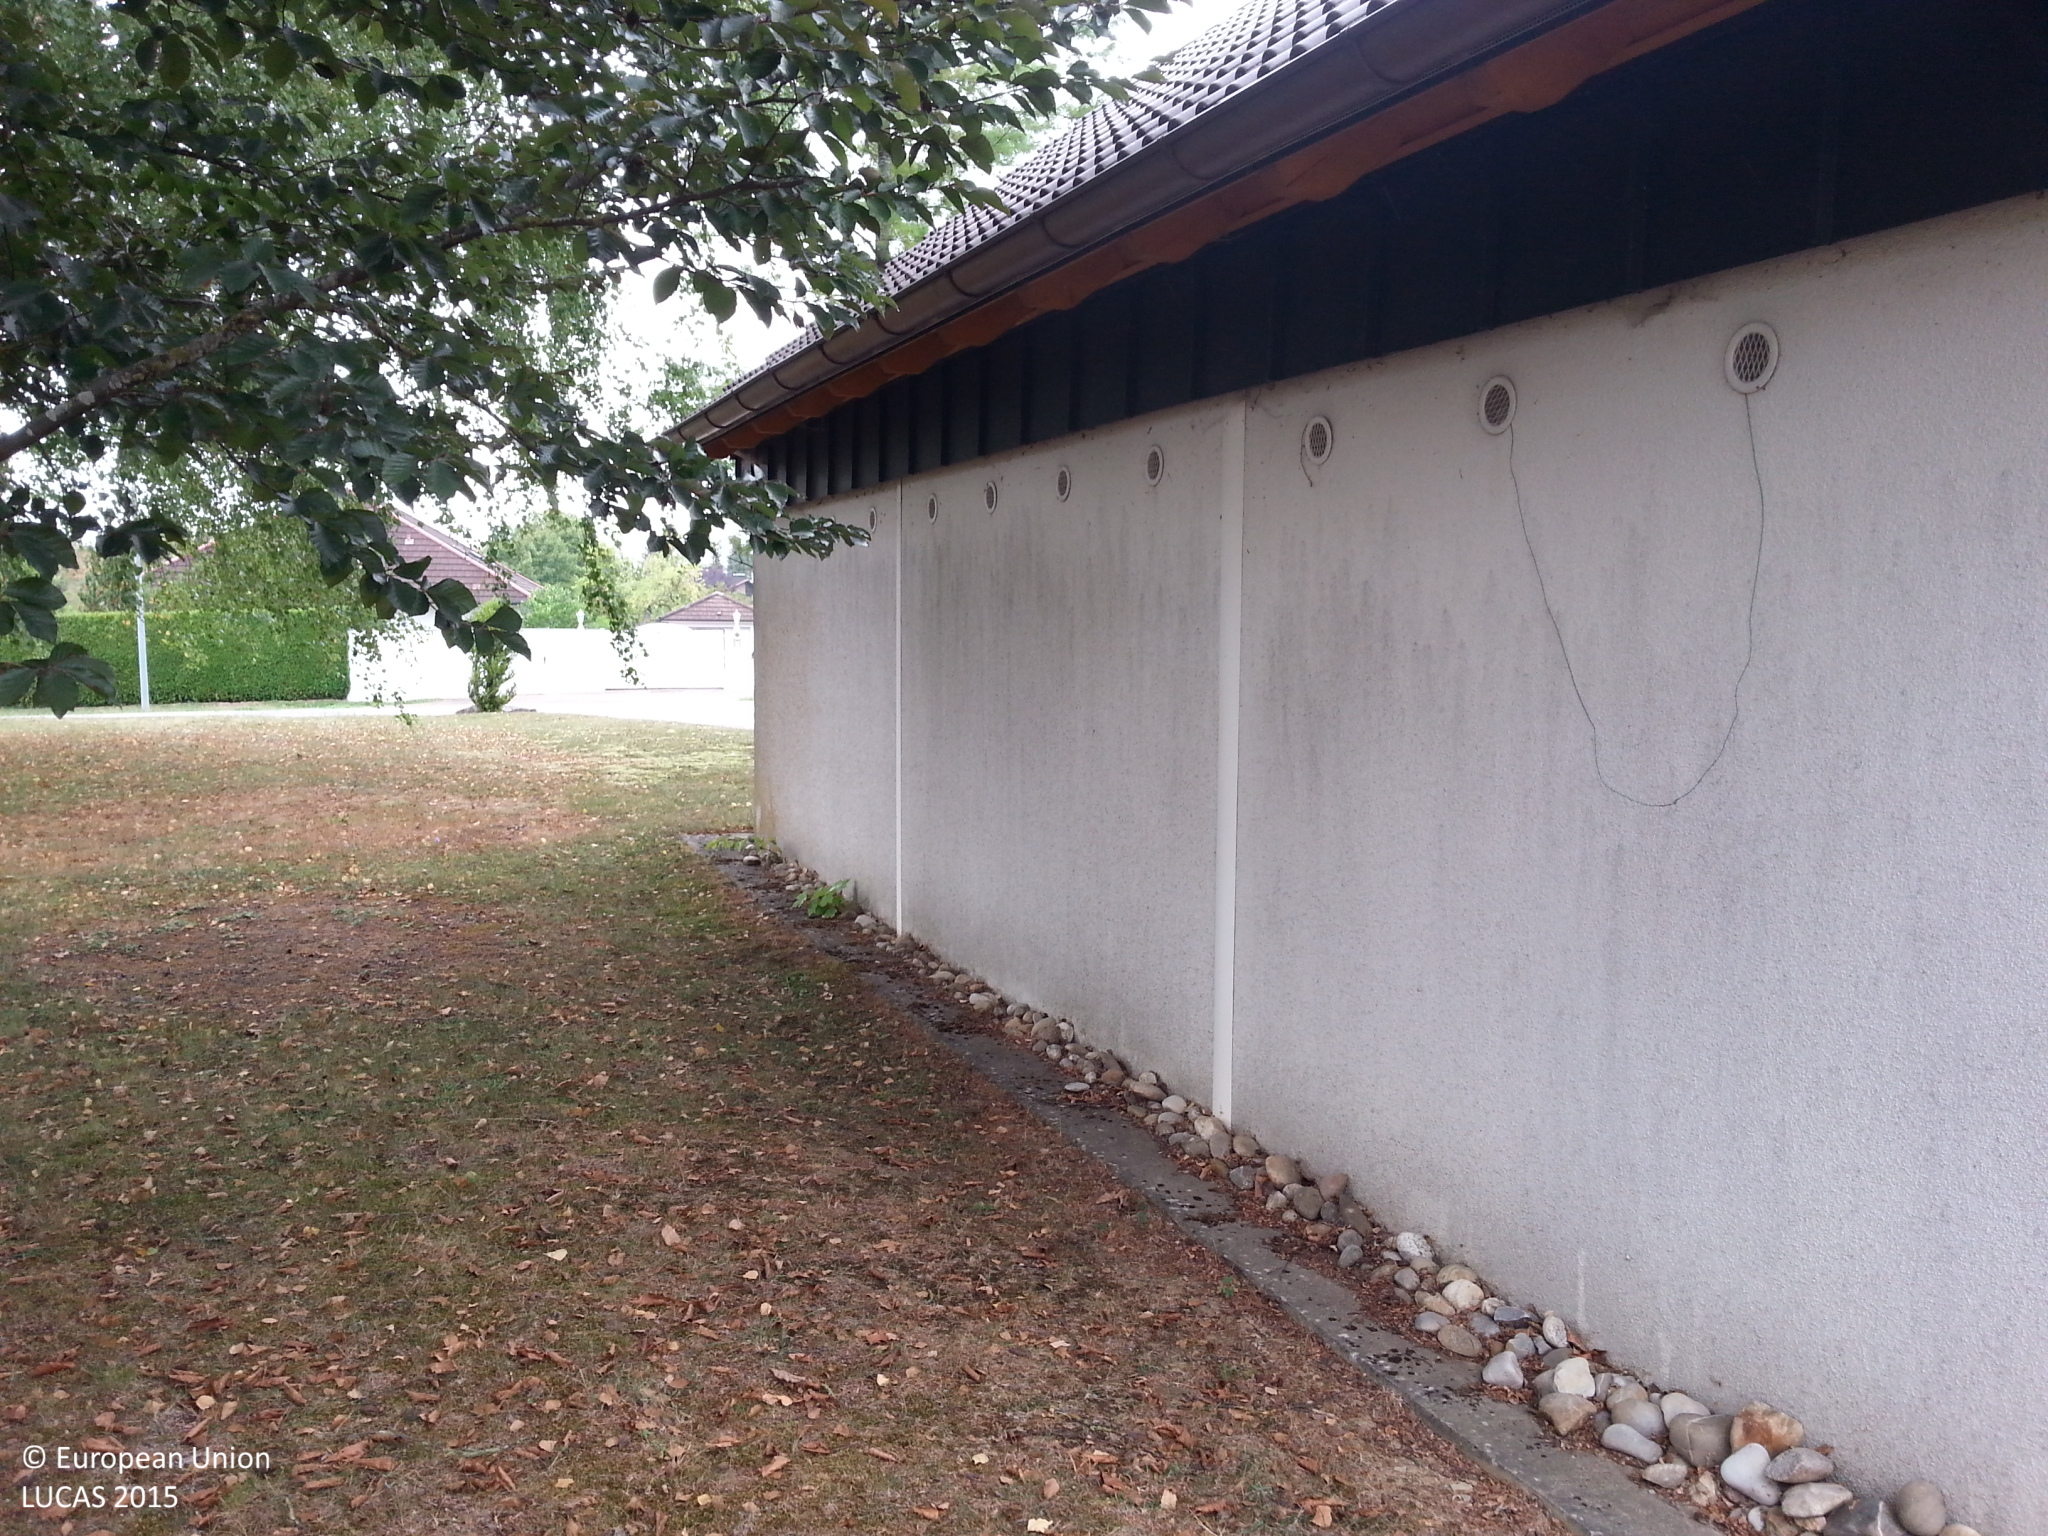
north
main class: Woodland
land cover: Broadleaved woodland
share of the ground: 50 - 75 %
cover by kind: broadleaved forest trees 70 %, herbaceous plants 30 %
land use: Residential
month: September
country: DE
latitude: 49.2490
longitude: 9.9313
